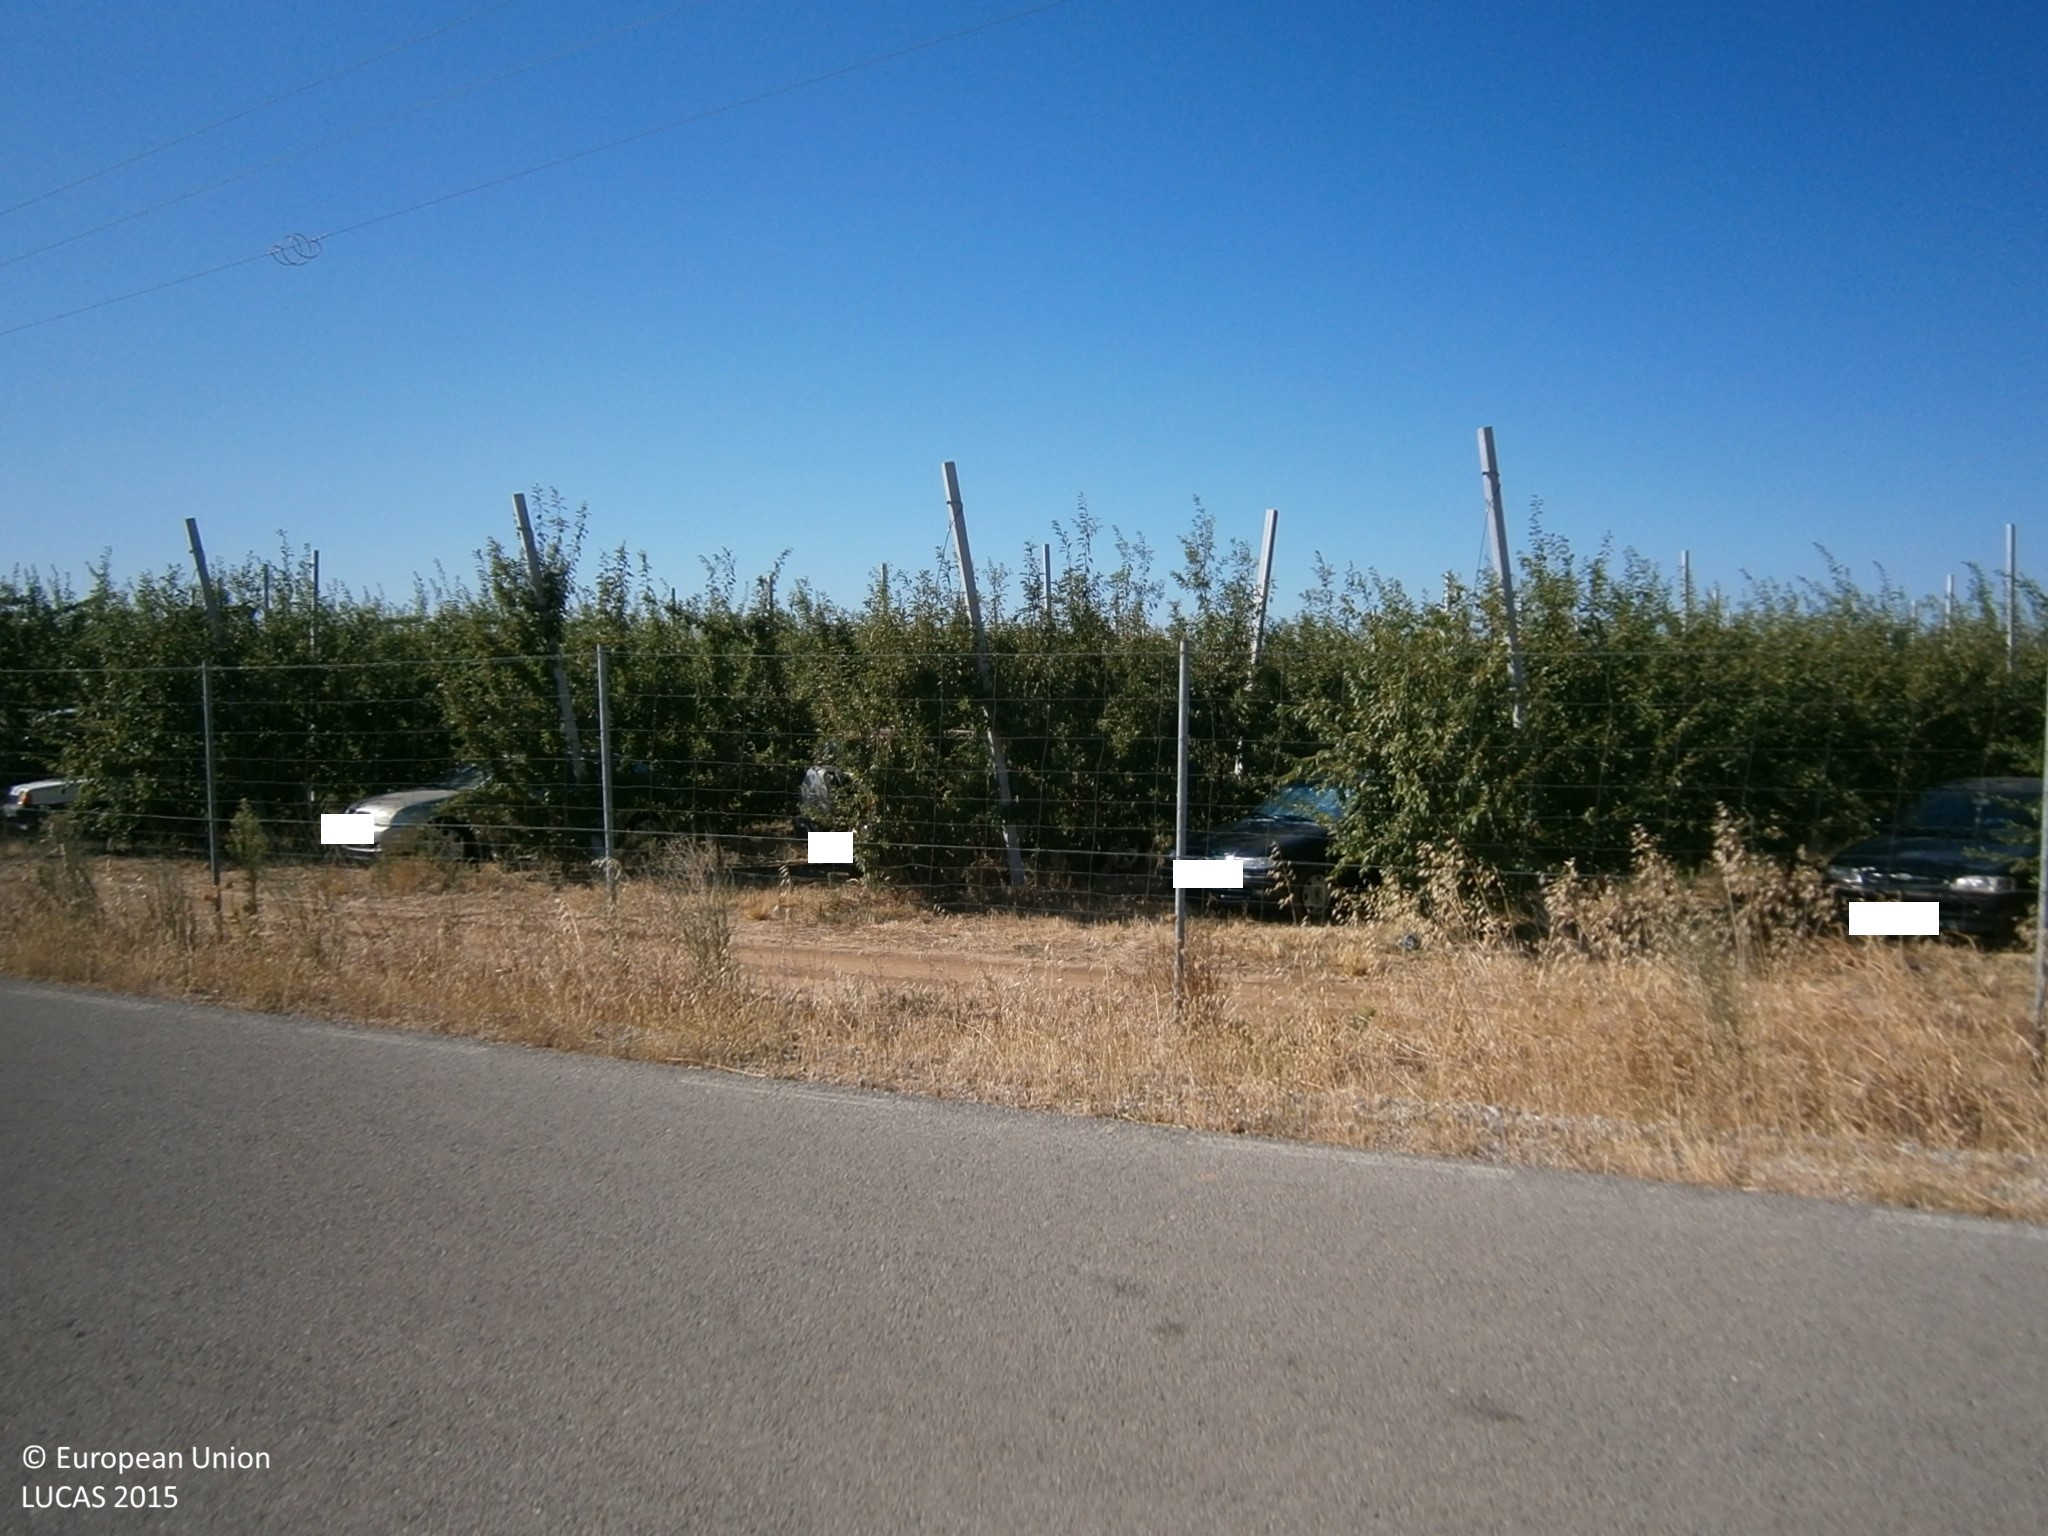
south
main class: Cropland
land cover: Maize
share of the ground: > 75 %
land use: Agriculture (excluding fallow land and kitchen gardens)
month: July
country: ES
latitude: 38.7311
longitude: -7.2240
